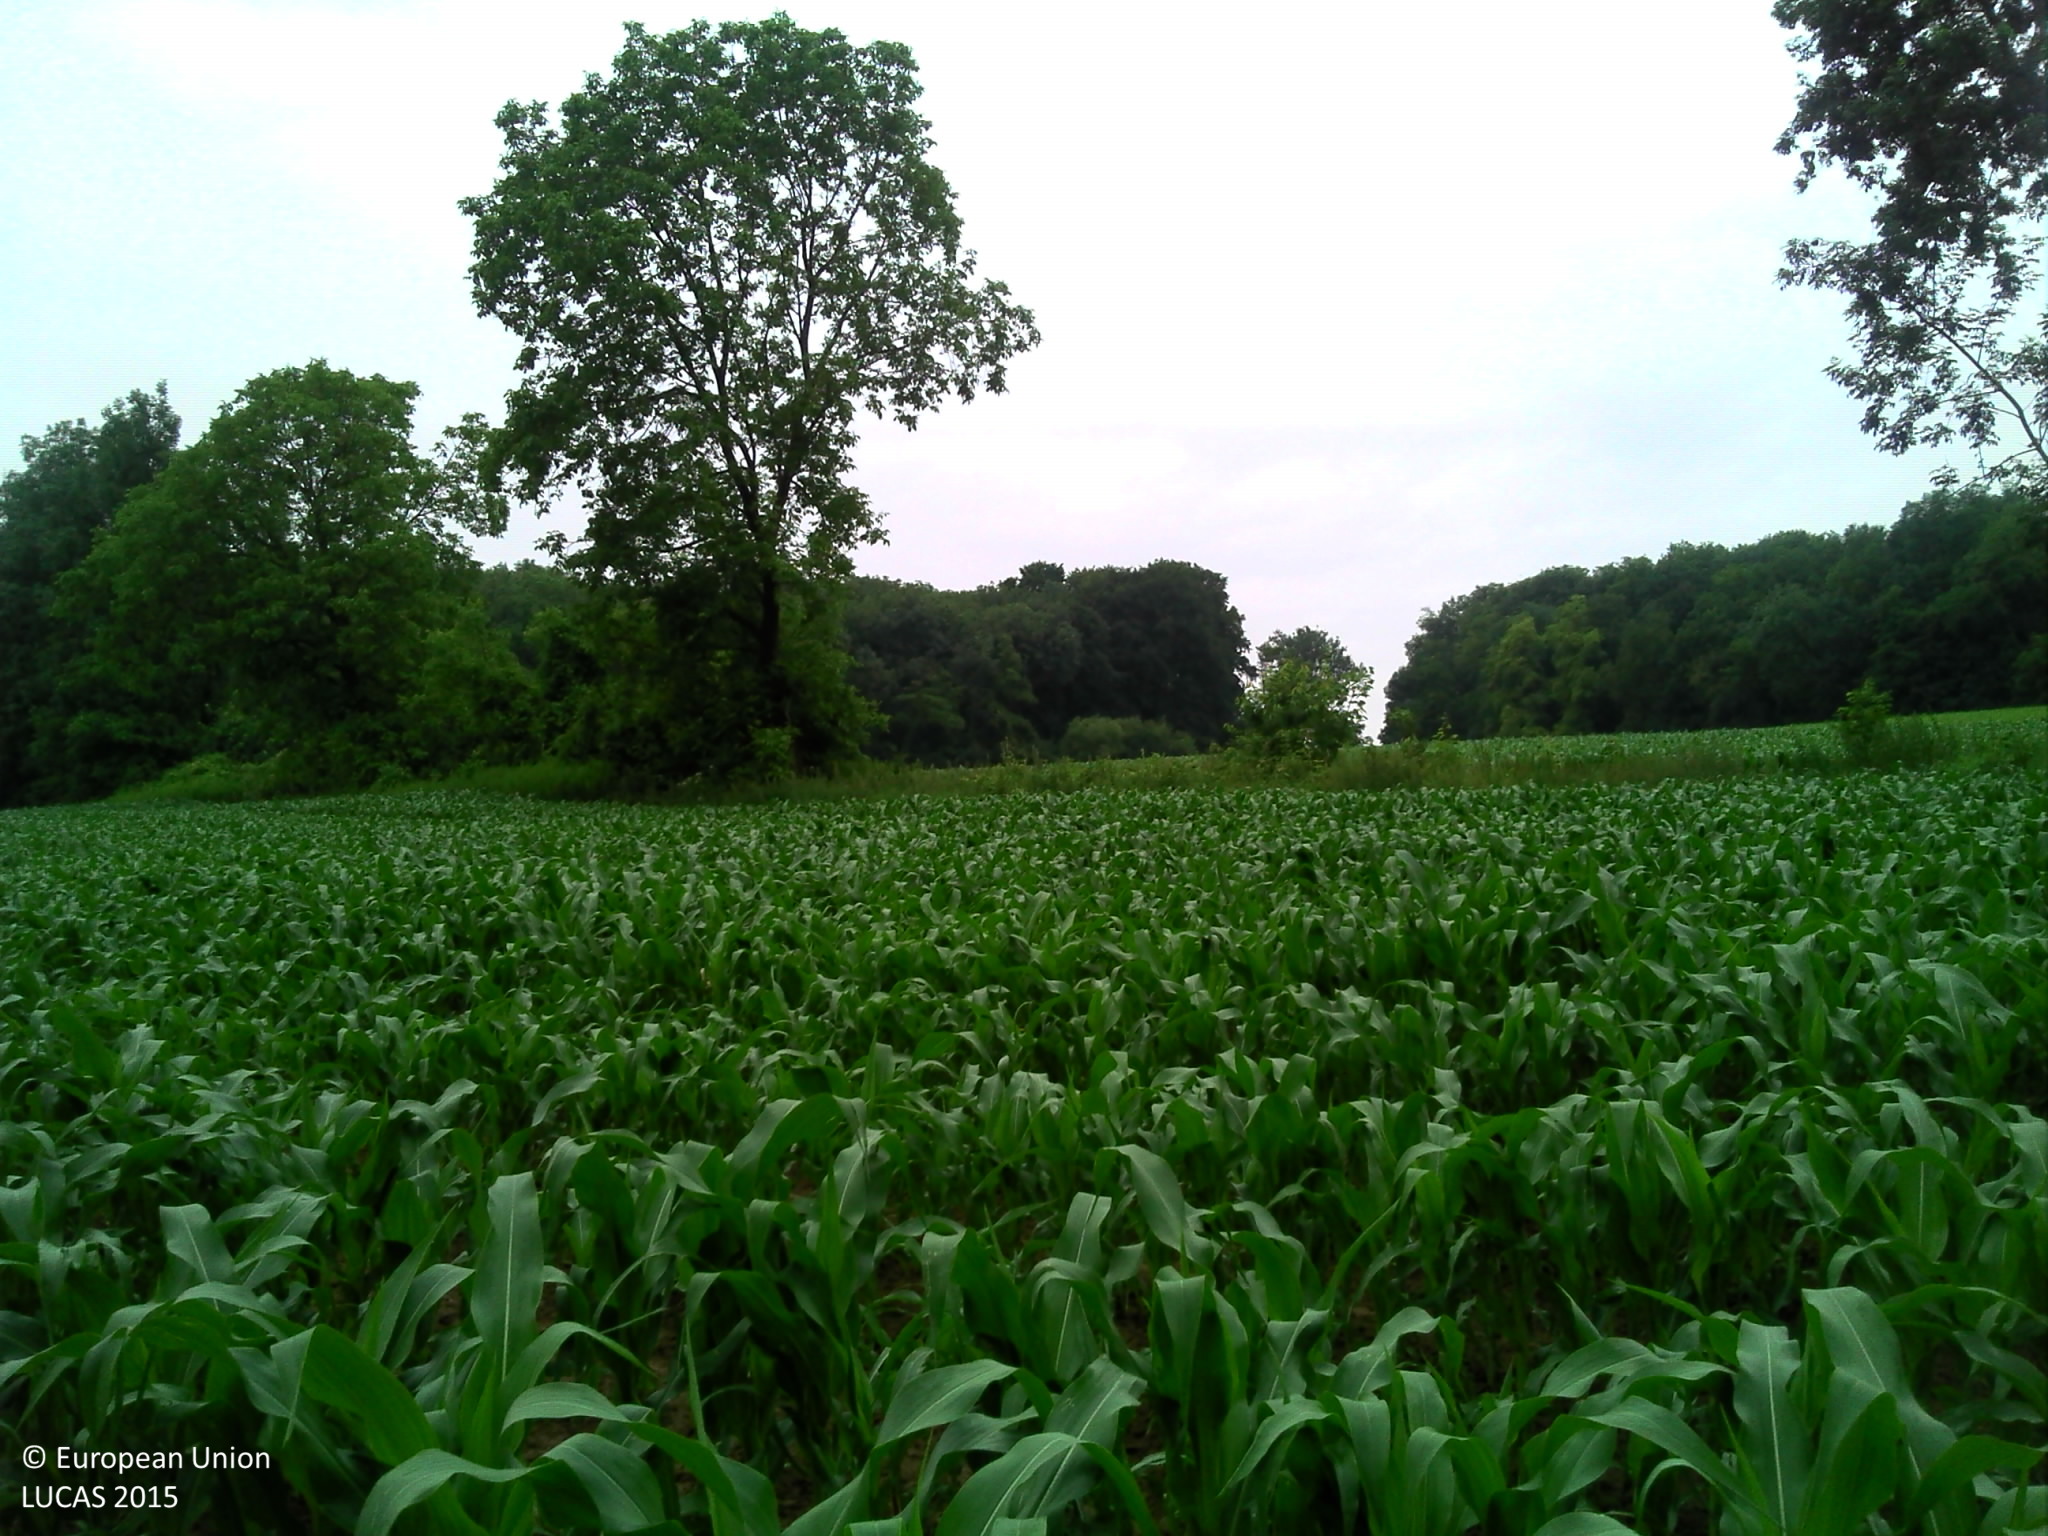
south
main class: Cropland
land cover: Maize
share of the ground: > 75 %
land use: Agriculture (excluding fallow land and kitchen gardens)
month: June
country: FR
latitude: 47.7062
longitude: 7.3760
